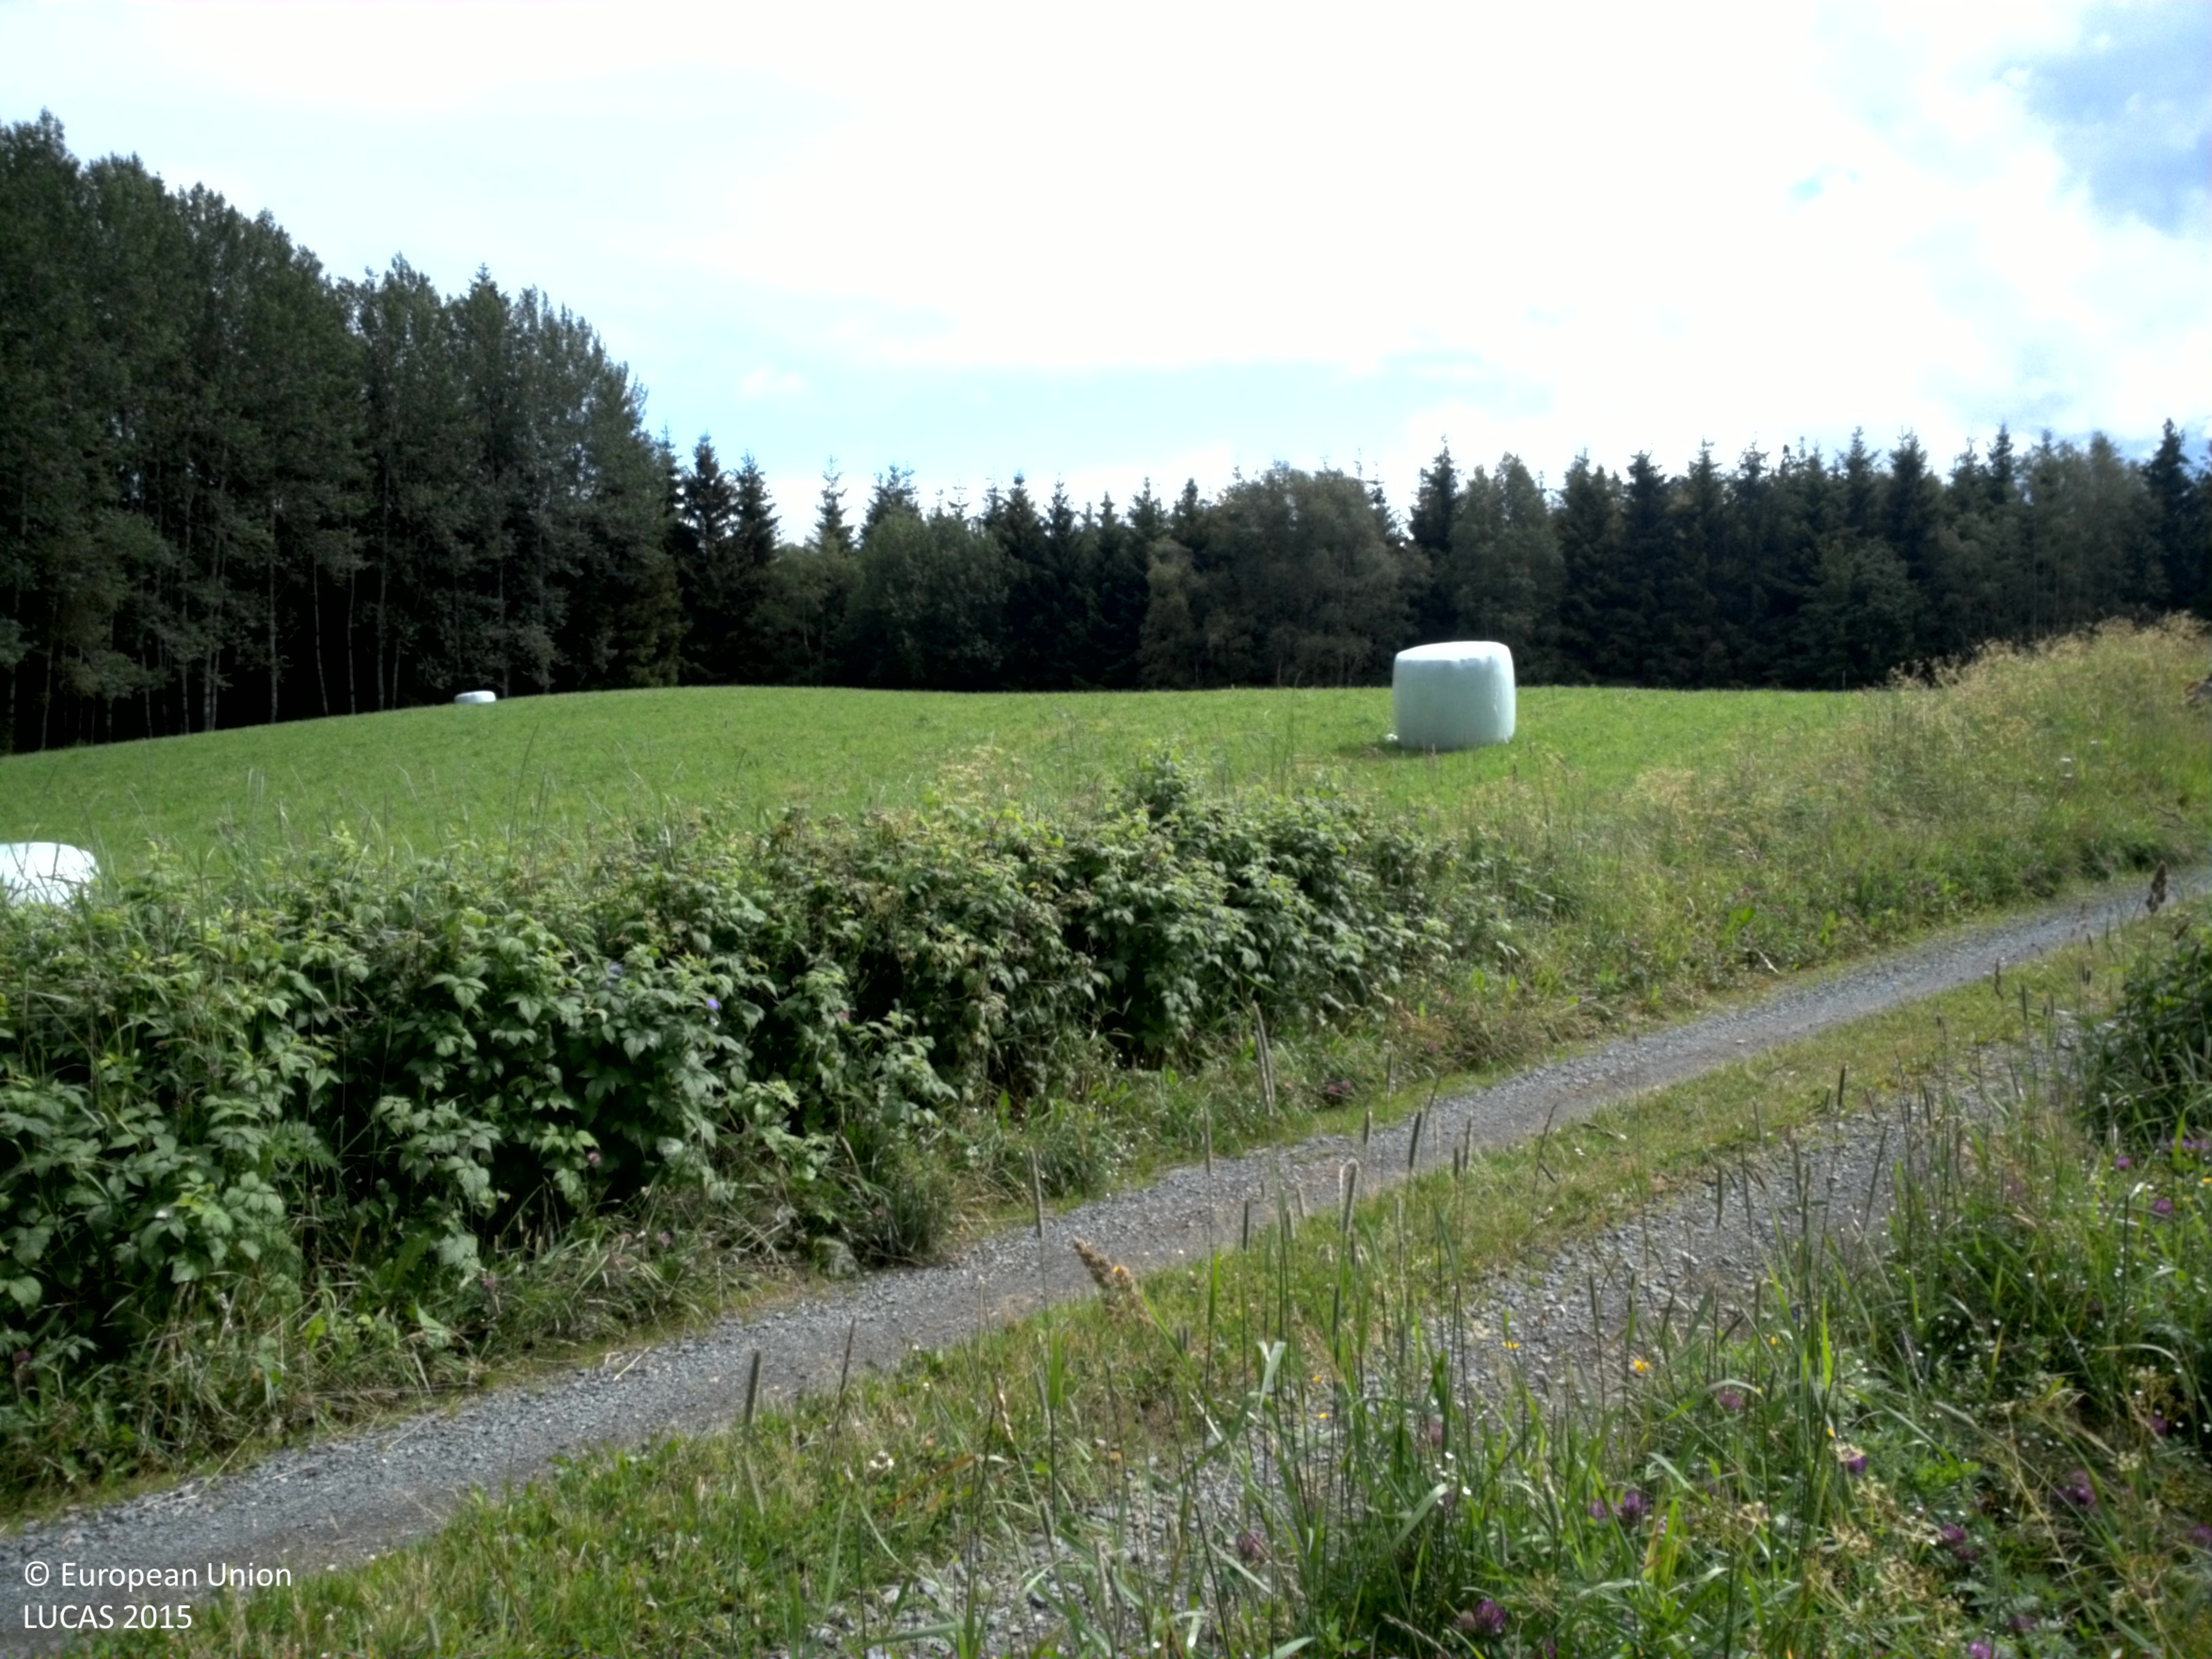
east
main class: Grassland
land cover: Grassland without tree/shrub cover
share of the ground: > 75 %
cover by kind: herbaceous plants 100 %
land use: Semi-natural and natural areas not in use
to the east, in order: Grassland without tree/shrub cover; Paved roads, cycling and walking lanes; Other leguminous and mixtures for fodder; Broadleaved woodland; Spruce dominated coniferous woodland
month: July
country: SE
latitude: 57.6554
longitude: 14.5705
